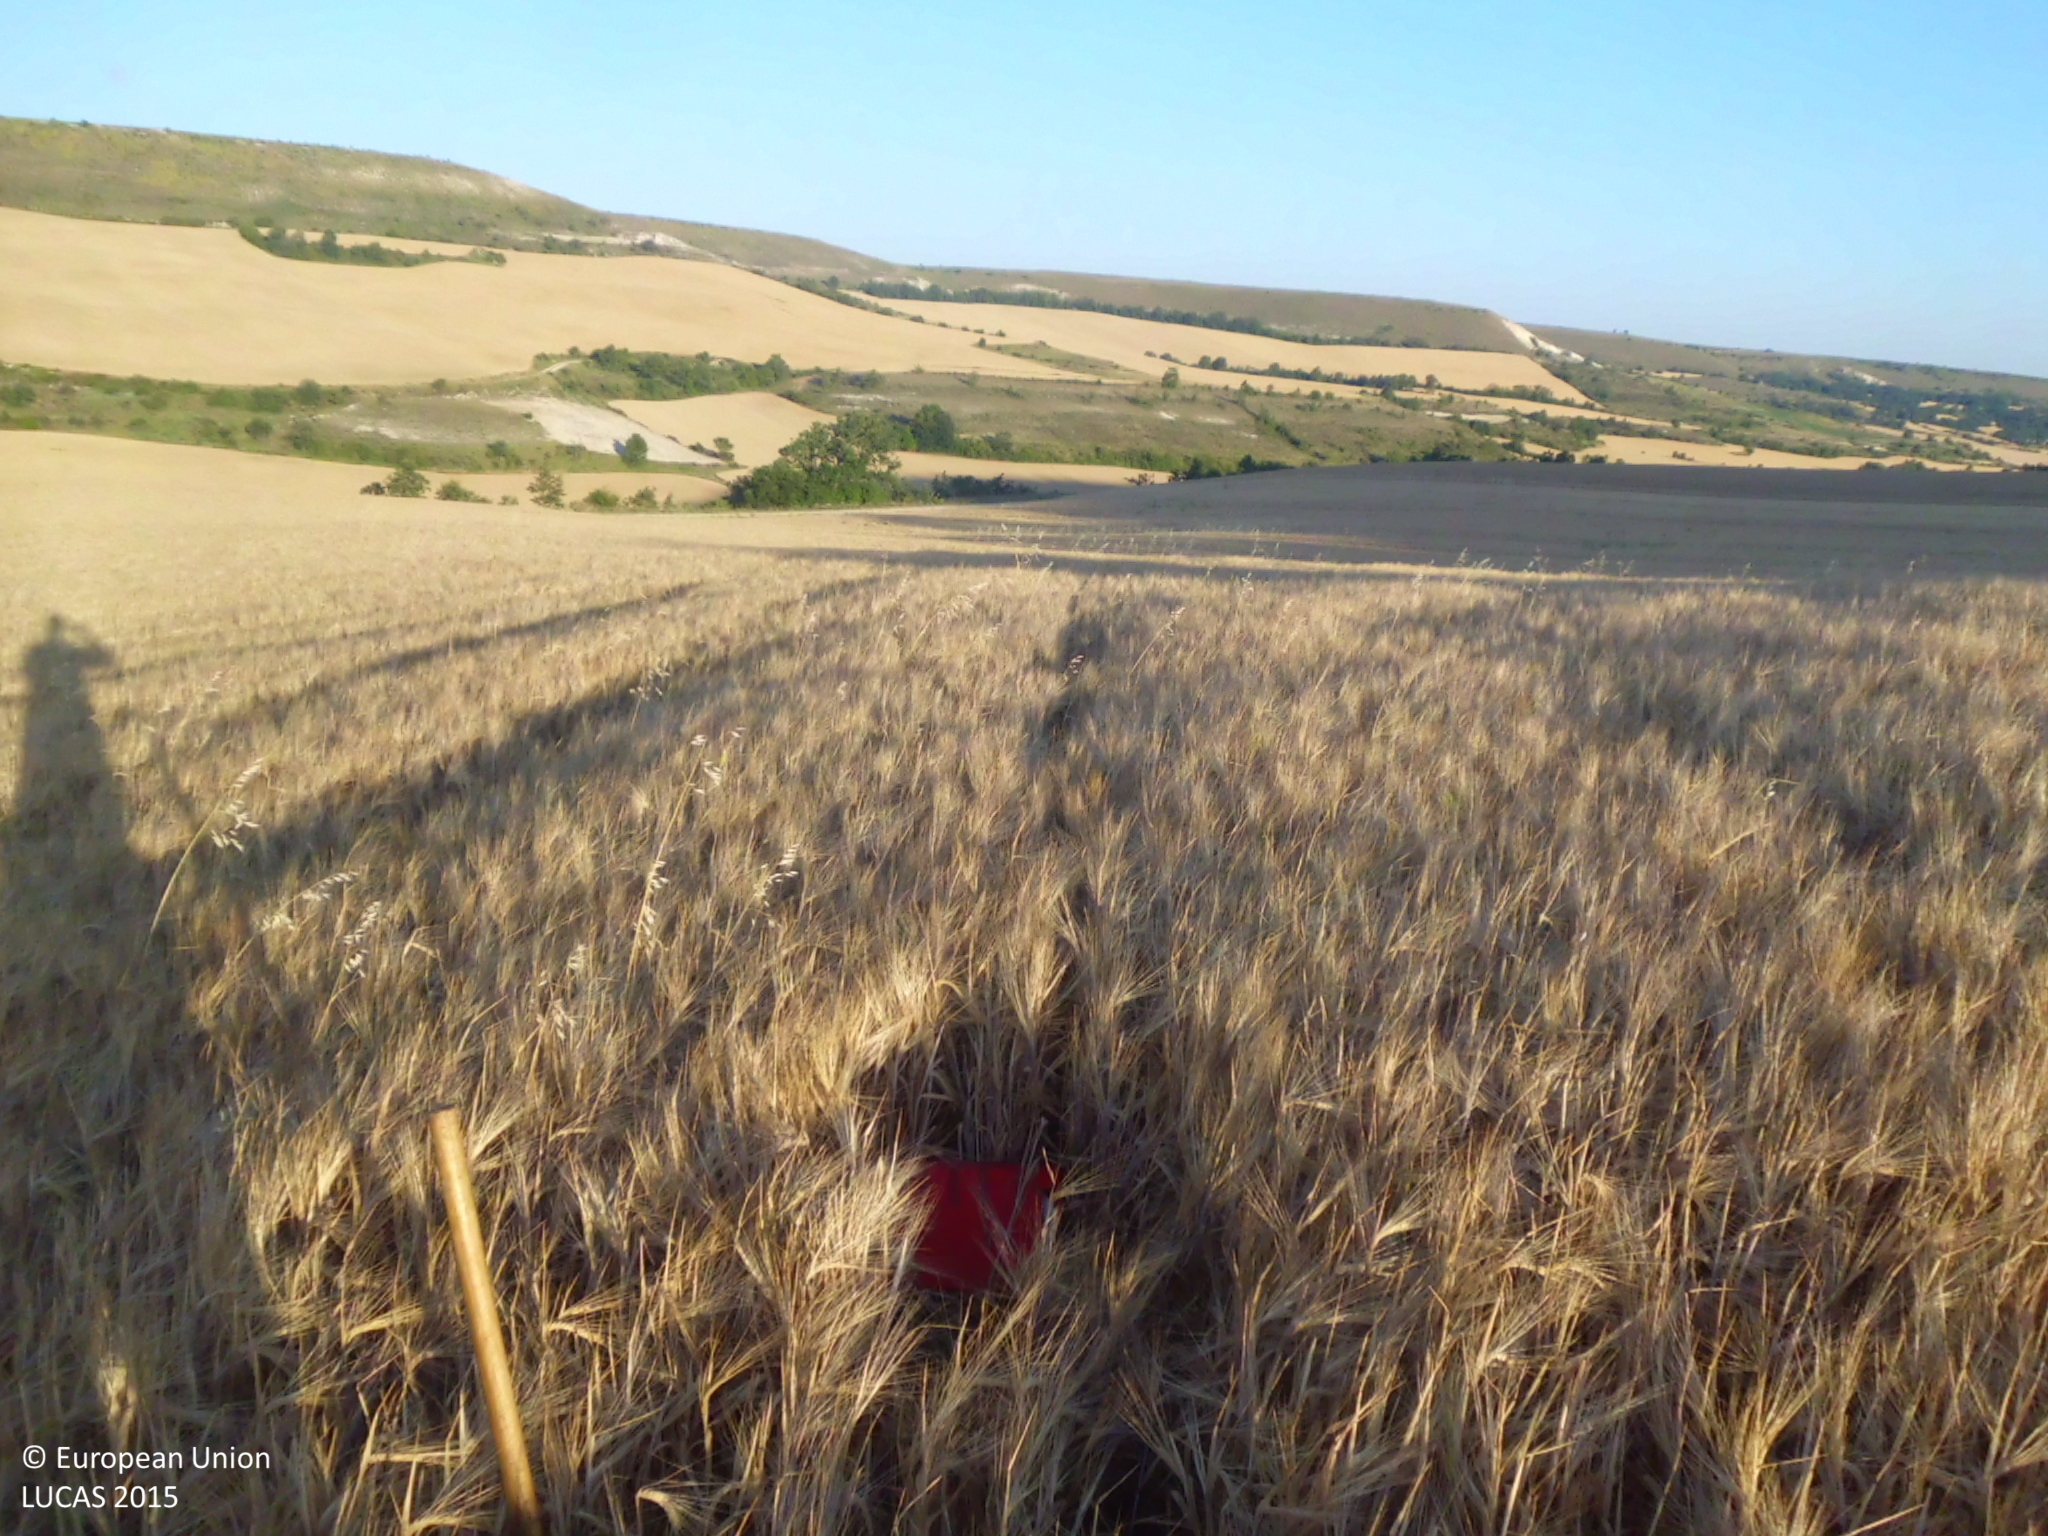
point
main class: Cropland
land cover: Barley
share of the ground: > 75 %
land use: Agriculture (excluding fallow land and kitchen gardens)
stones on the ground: < 10 %
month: July
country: ES
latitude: 42.5087
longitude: -3.8041
